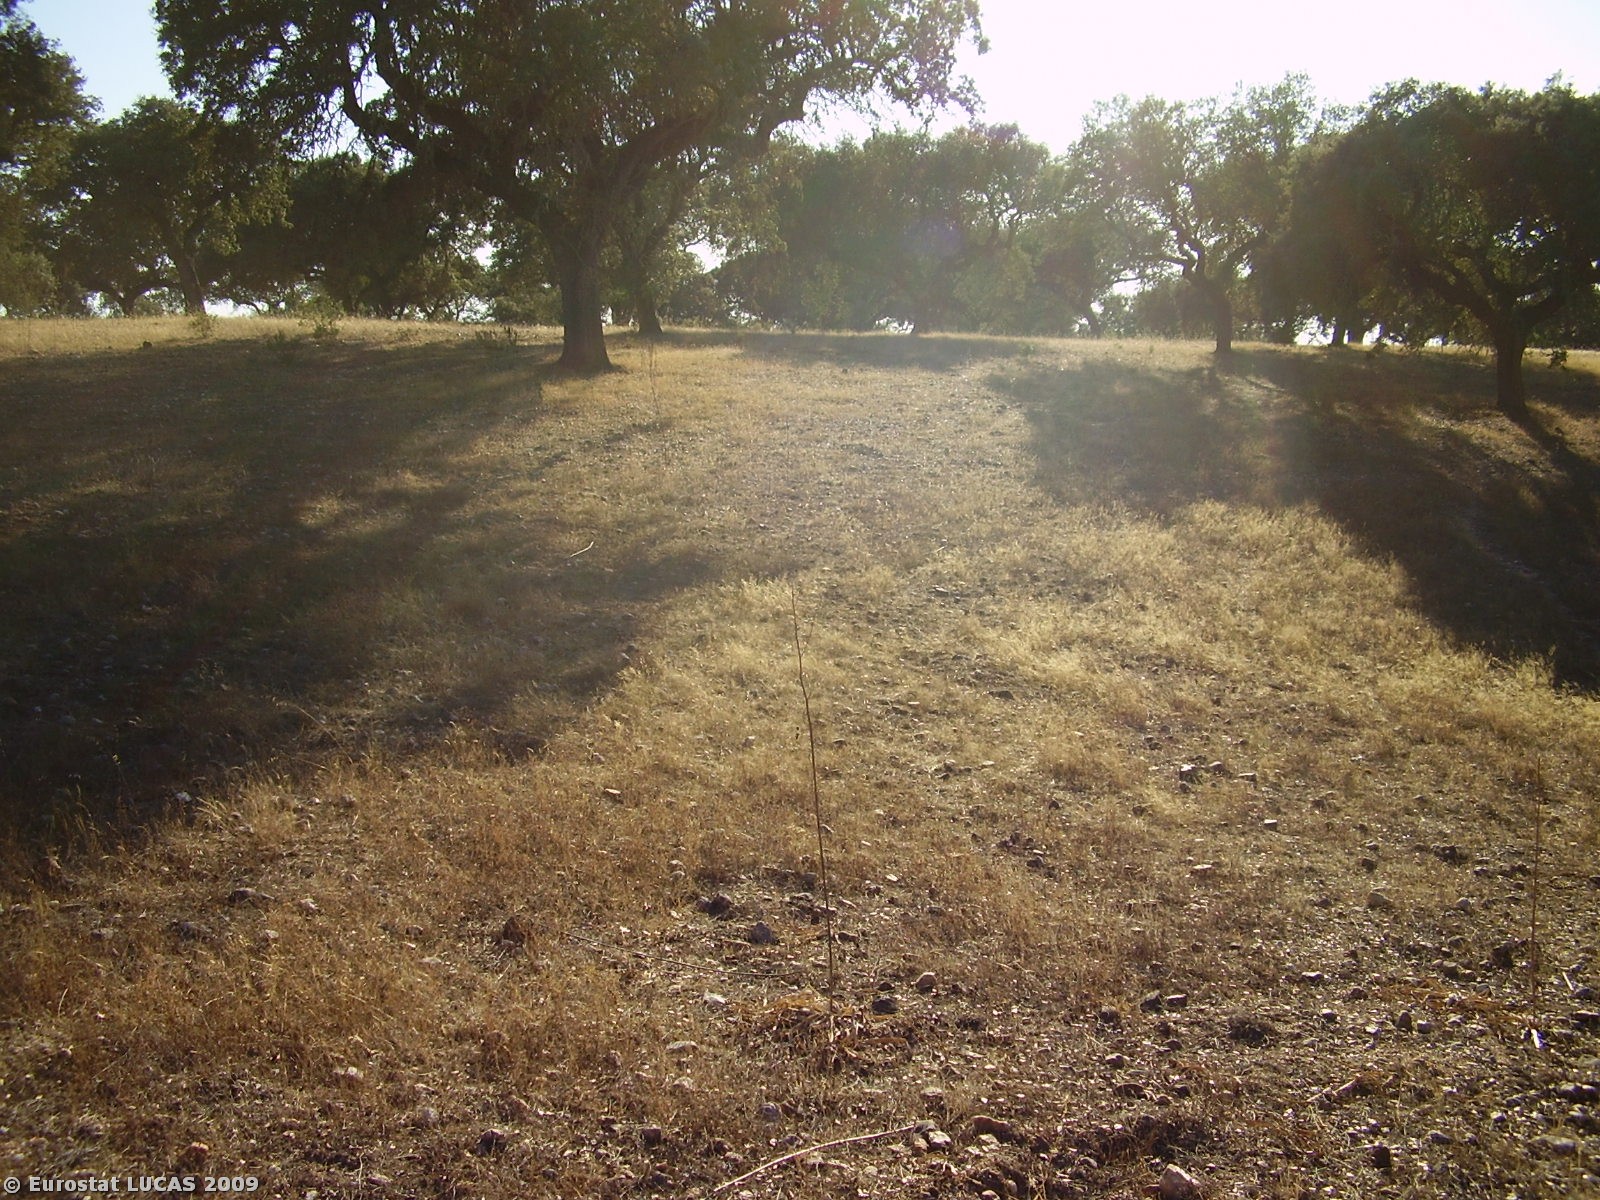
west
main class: Woodland
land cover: Broadleaved woodland
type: broadleaved evergreen forest
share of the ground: 25 - 50 %
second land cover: Spontaneously vegetated surfaces
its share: 10 - 25 %
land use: Forestry
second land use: Fallow land
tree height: > 5 m
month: July
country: PT
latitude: 38.9318
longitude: -8.0335
